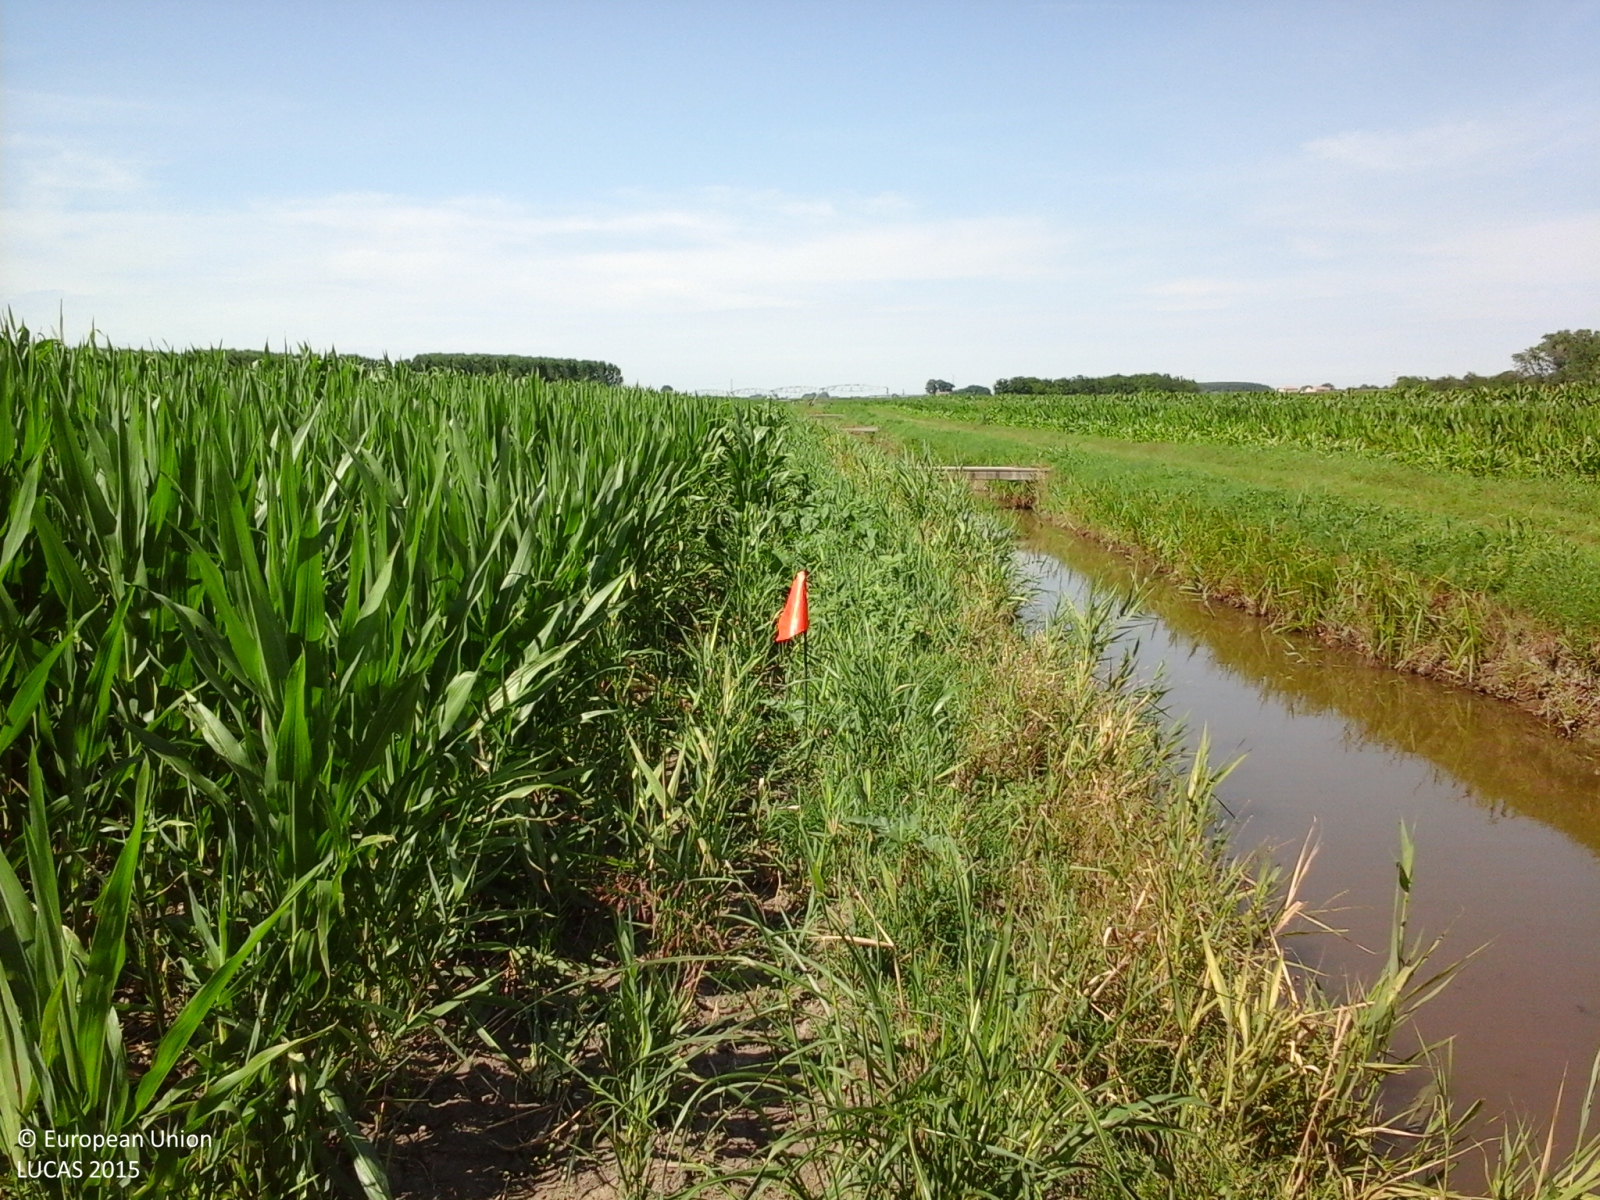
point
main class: Cropland
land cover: Maize
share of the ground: > 75 %
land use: Agriculture (excluding fallow land and kitchen gardens)
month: June
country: IT
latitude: 44.9588
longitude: 12.1891
